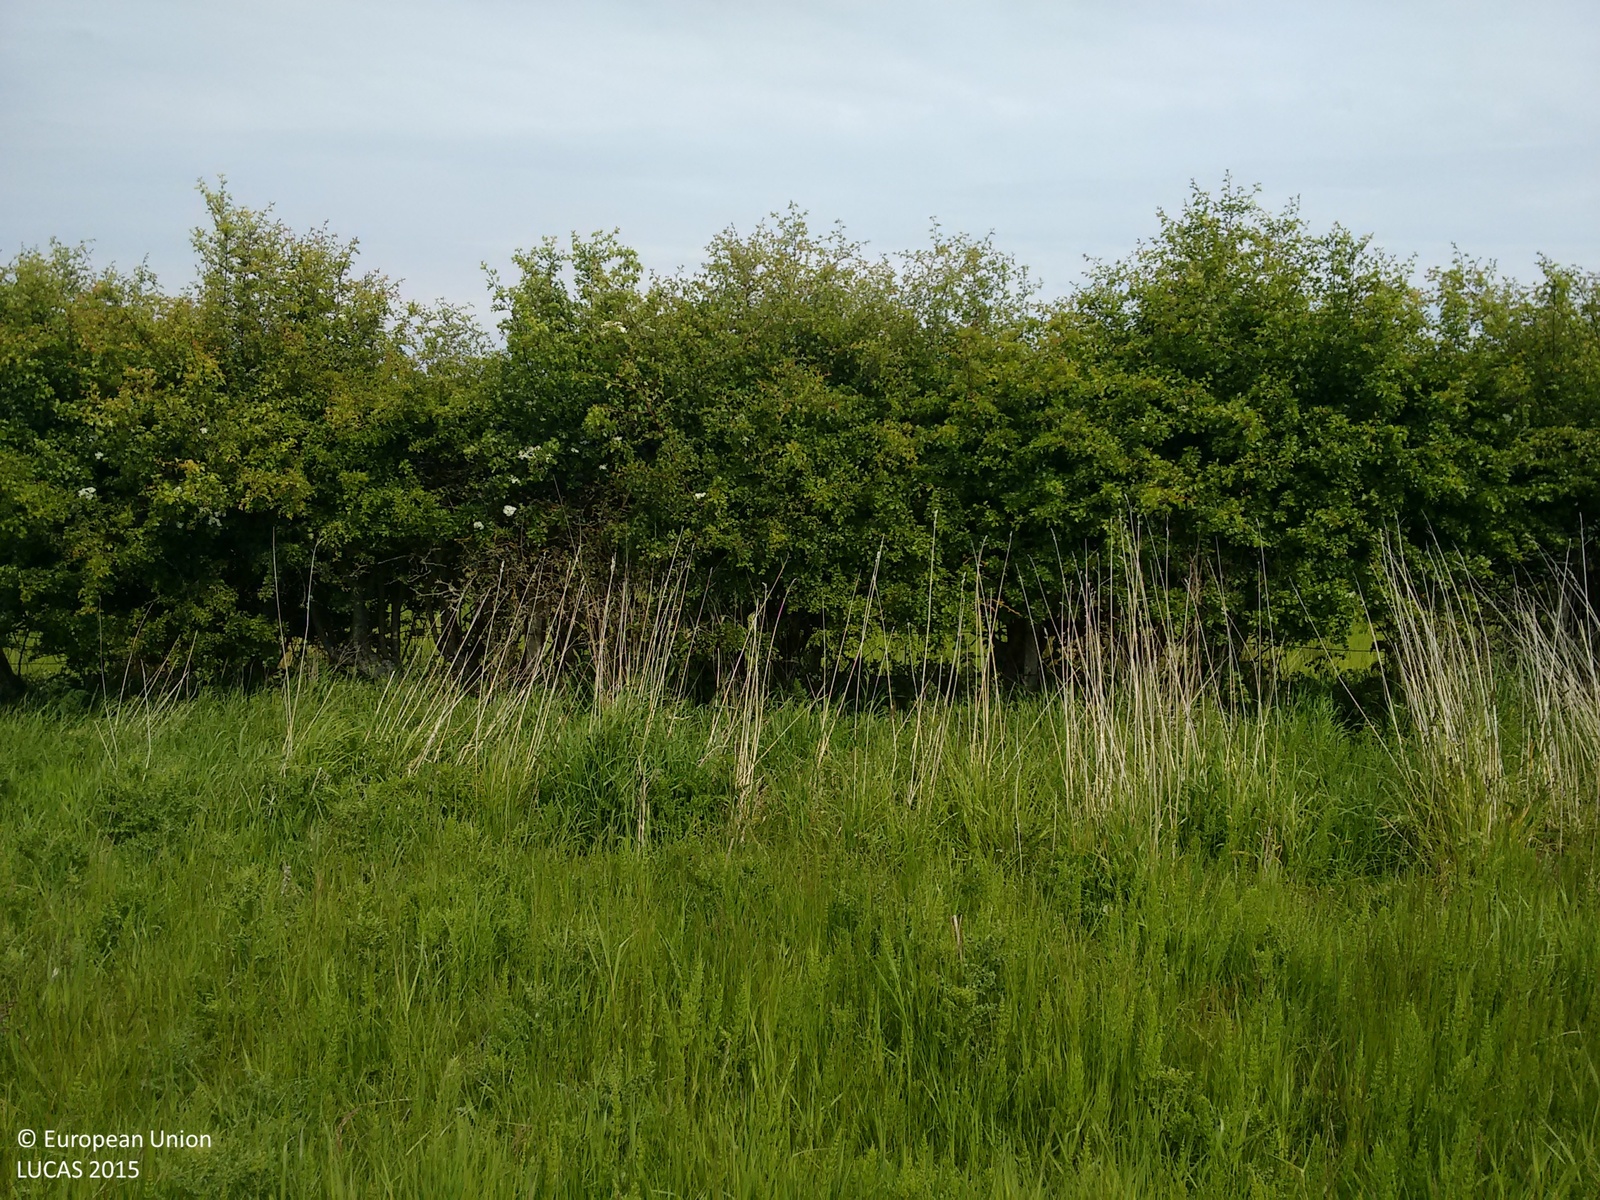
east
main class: Cropland
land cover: Common wheat
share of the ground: > 75 %
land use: Agriculture (excluding fallow land and kitchen gardens)
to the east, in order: Common wheat; Grassland without tree/shrub cover; Electric lines; Fences; Shruby margins; Grassland without tree/shrub cover; Common wheat
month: June
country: GB
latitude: 55.4383
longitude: -1.6336
